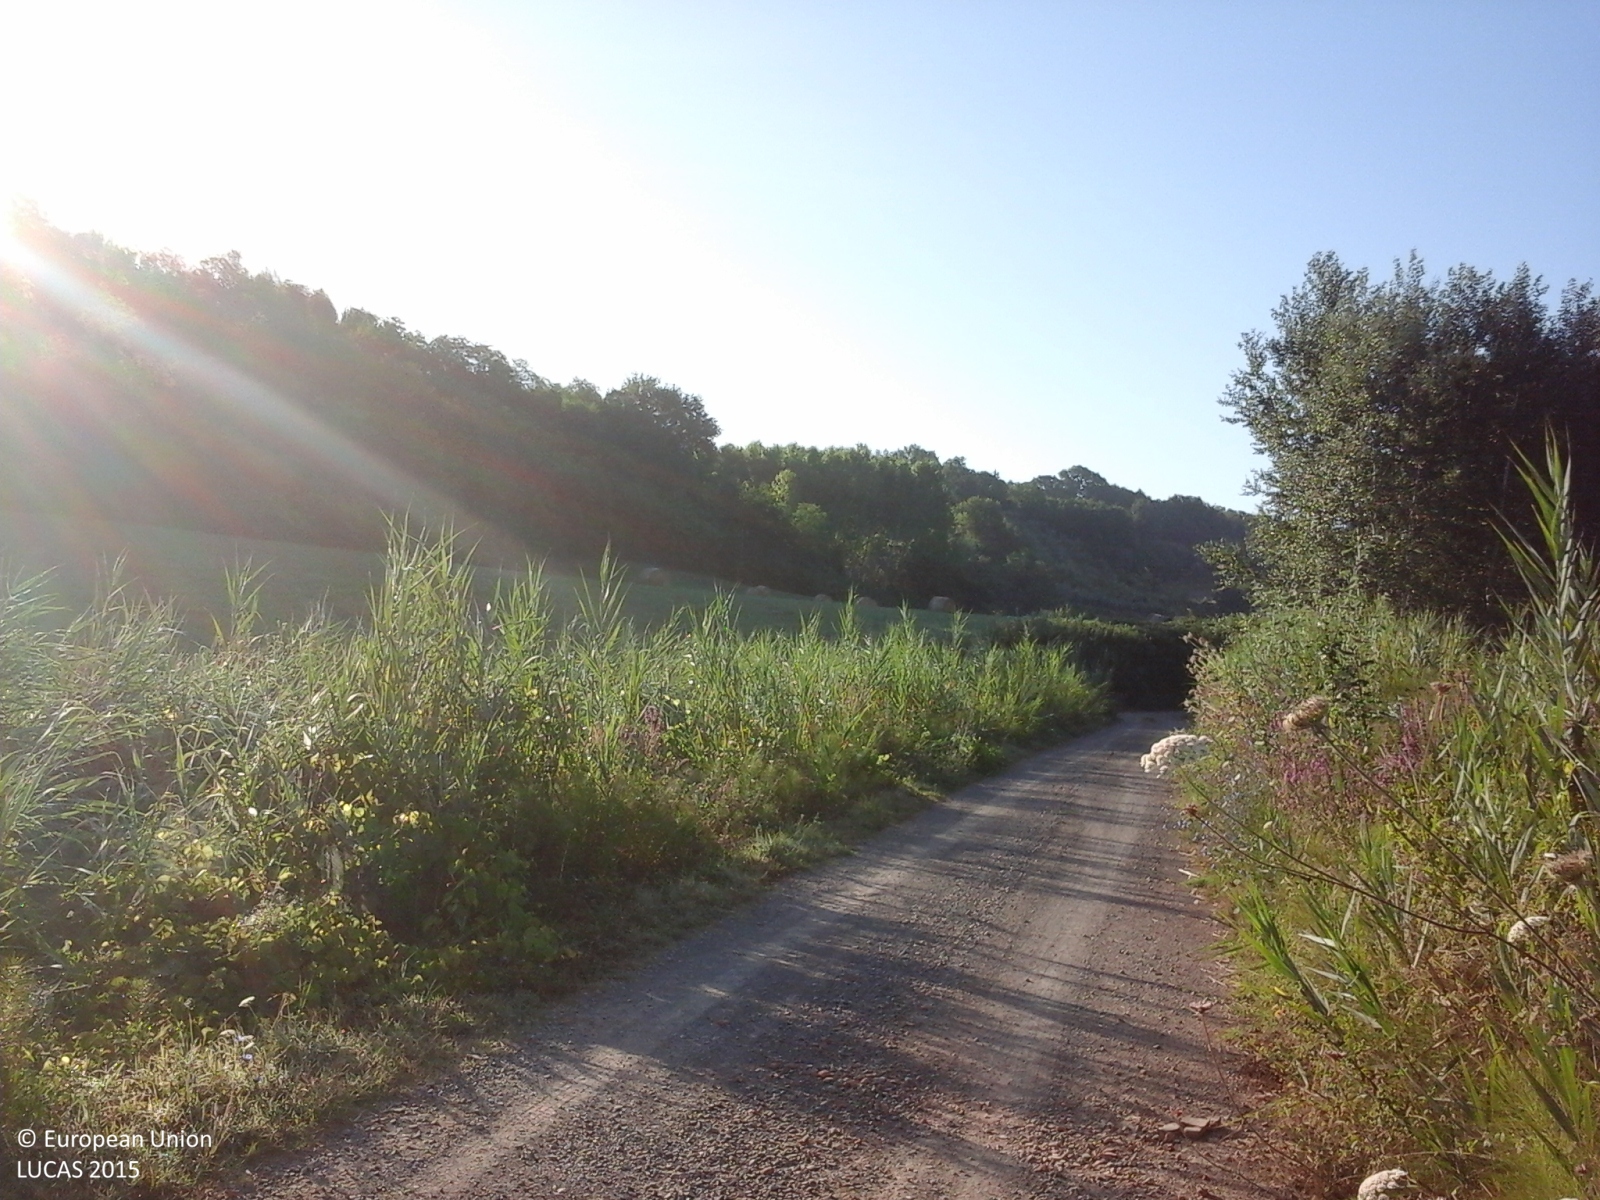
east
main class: Cropland
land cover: Other leguminous and mixtures for fodder
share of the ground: > 75 %
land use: Agriculture (excluding fallow land and kitchen gardens)
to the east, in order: Other leguminous and mixtures for fodder; Broadleaved woodland; Other leguminous and mixtures for fodder; Paved roads, cycling and walking lanes
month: July
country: IT
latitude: 43.5361
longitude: 10.7281
